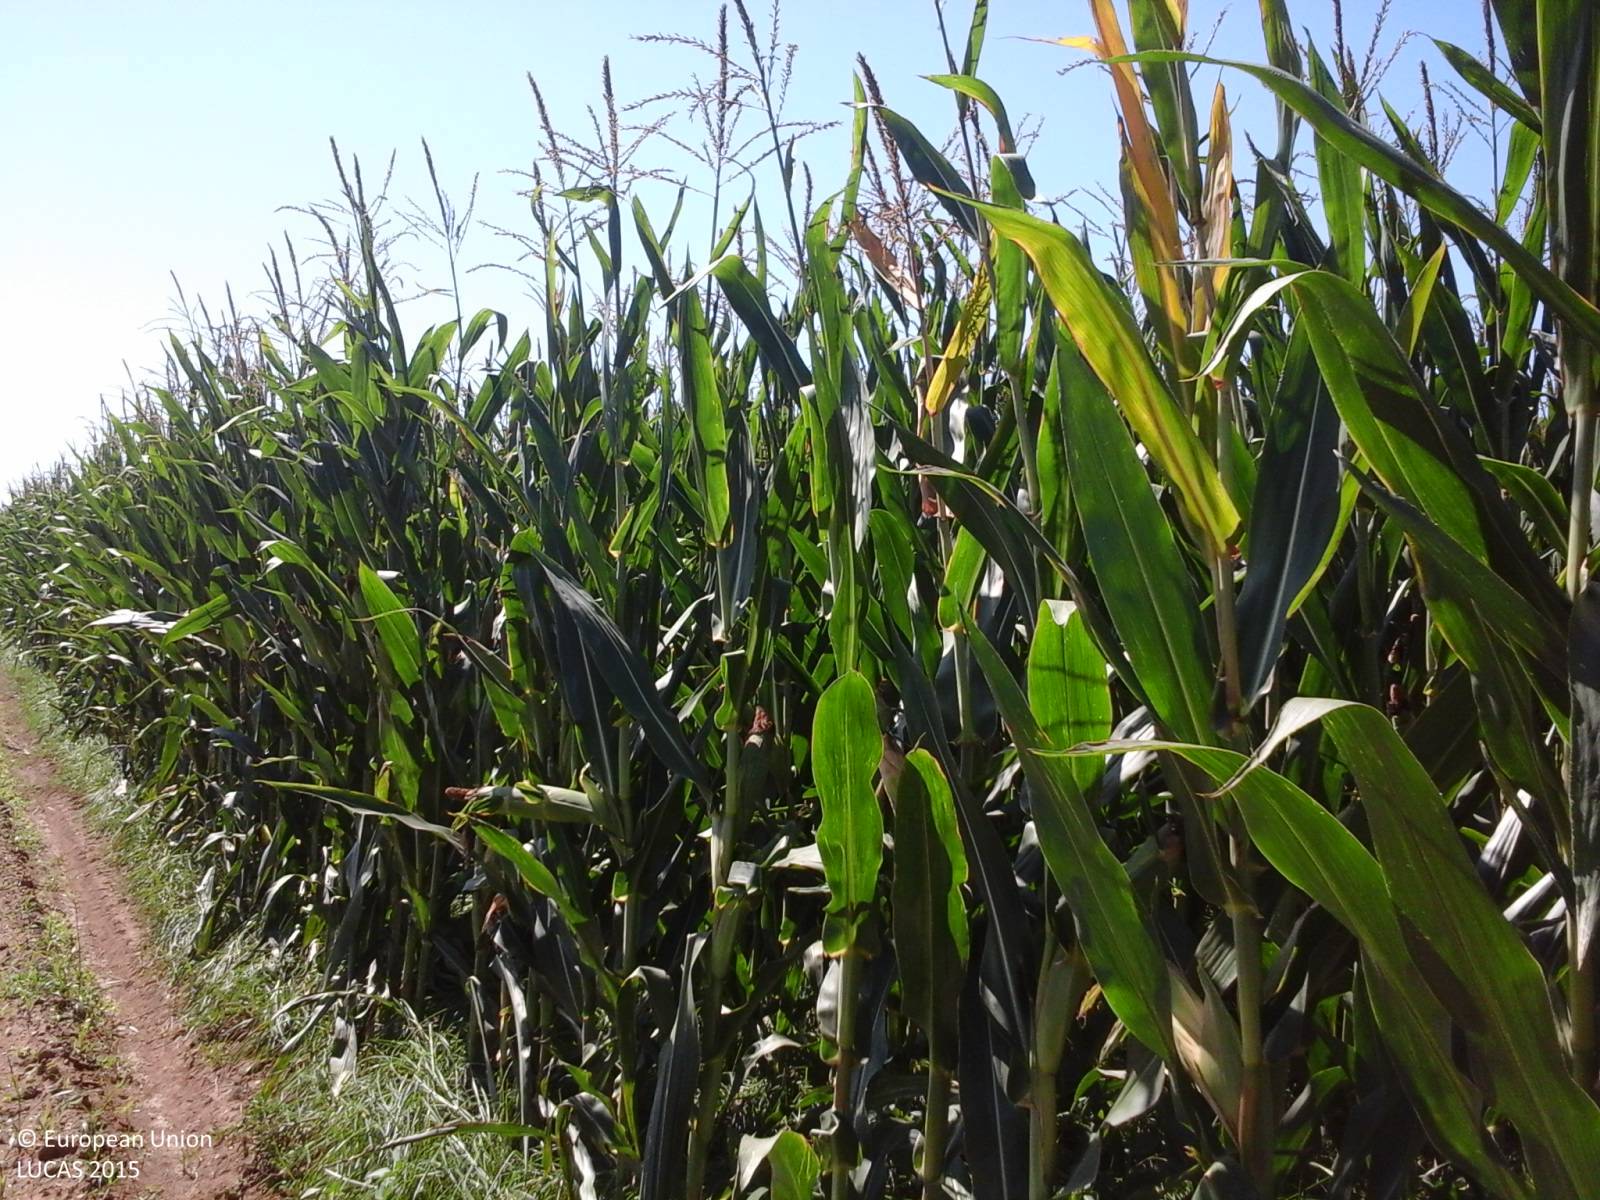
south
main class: Cropland
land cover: Maize
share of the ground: > 75 %
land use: Agriculture (excluding fallow land and kitchen gardens)
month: August
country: IT
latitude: 41.3630
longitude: 12.9646
